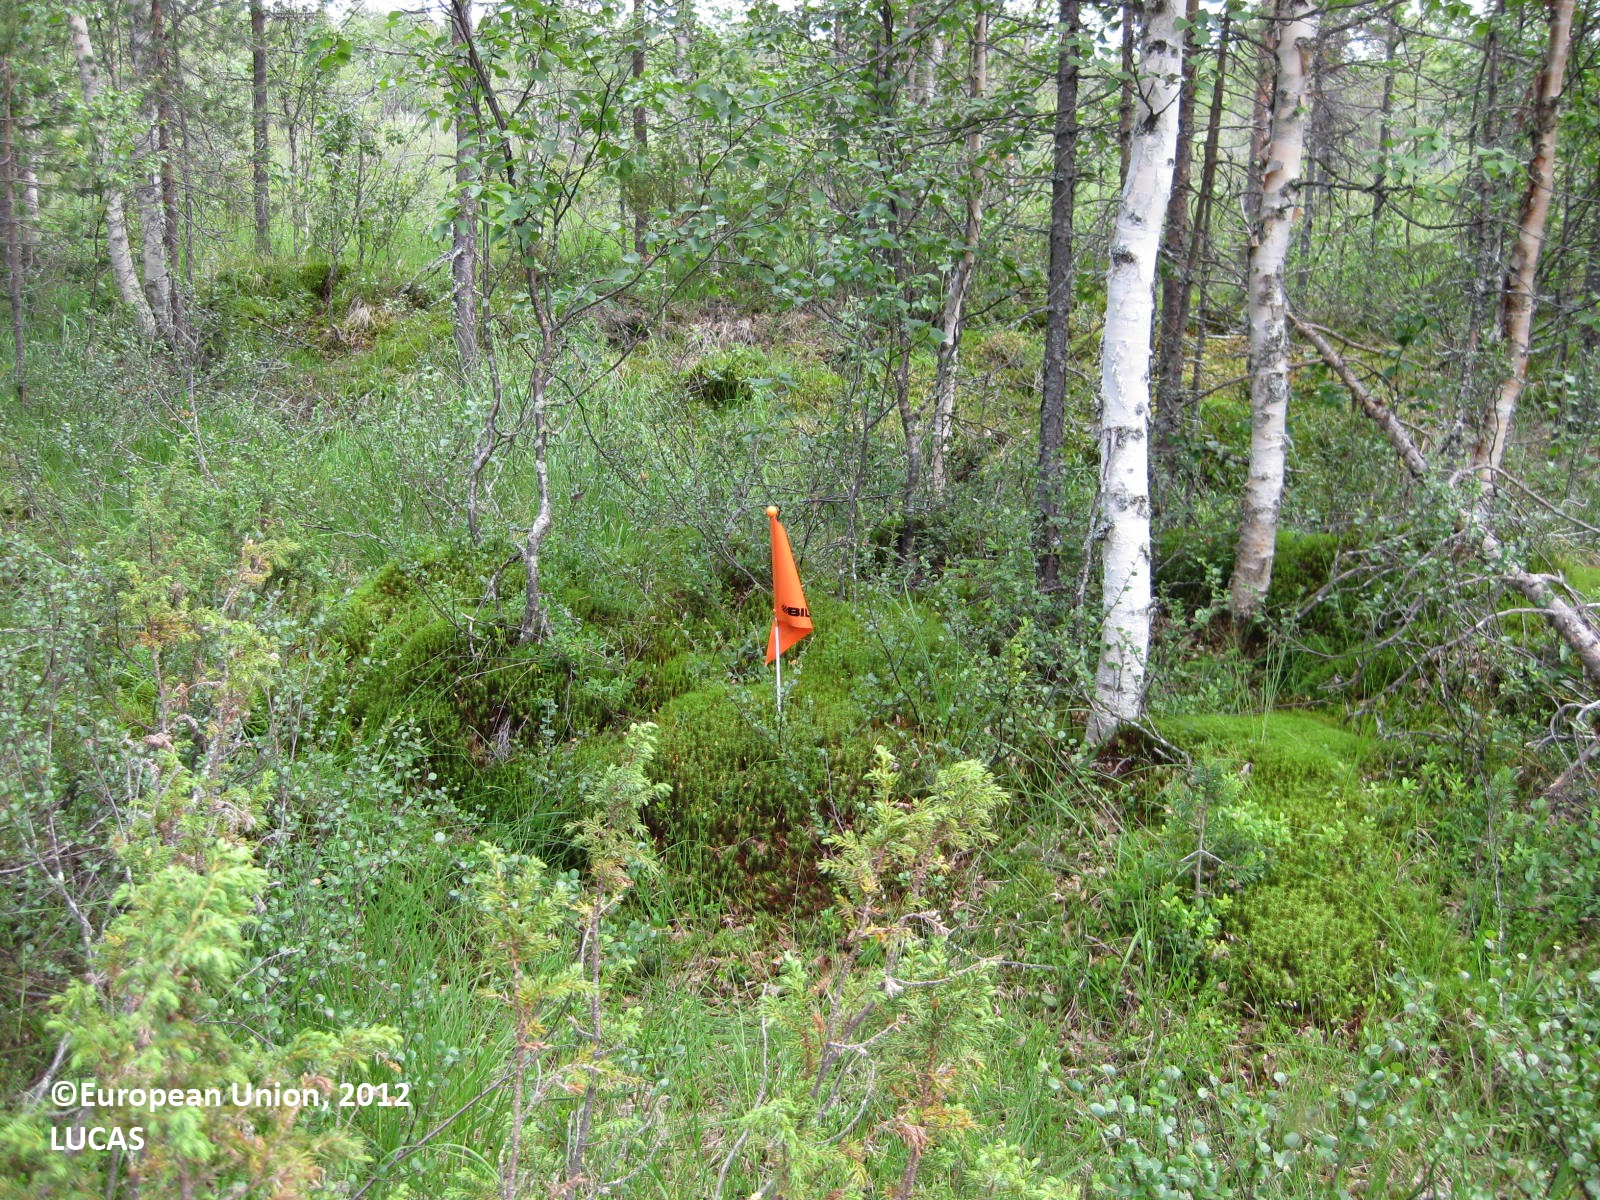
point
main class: Woodland
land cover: Pine dominated mixed woodland
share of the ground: > 75 %
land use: Forestry
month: July
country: FI
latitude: 65.6678
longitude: 29.3073
